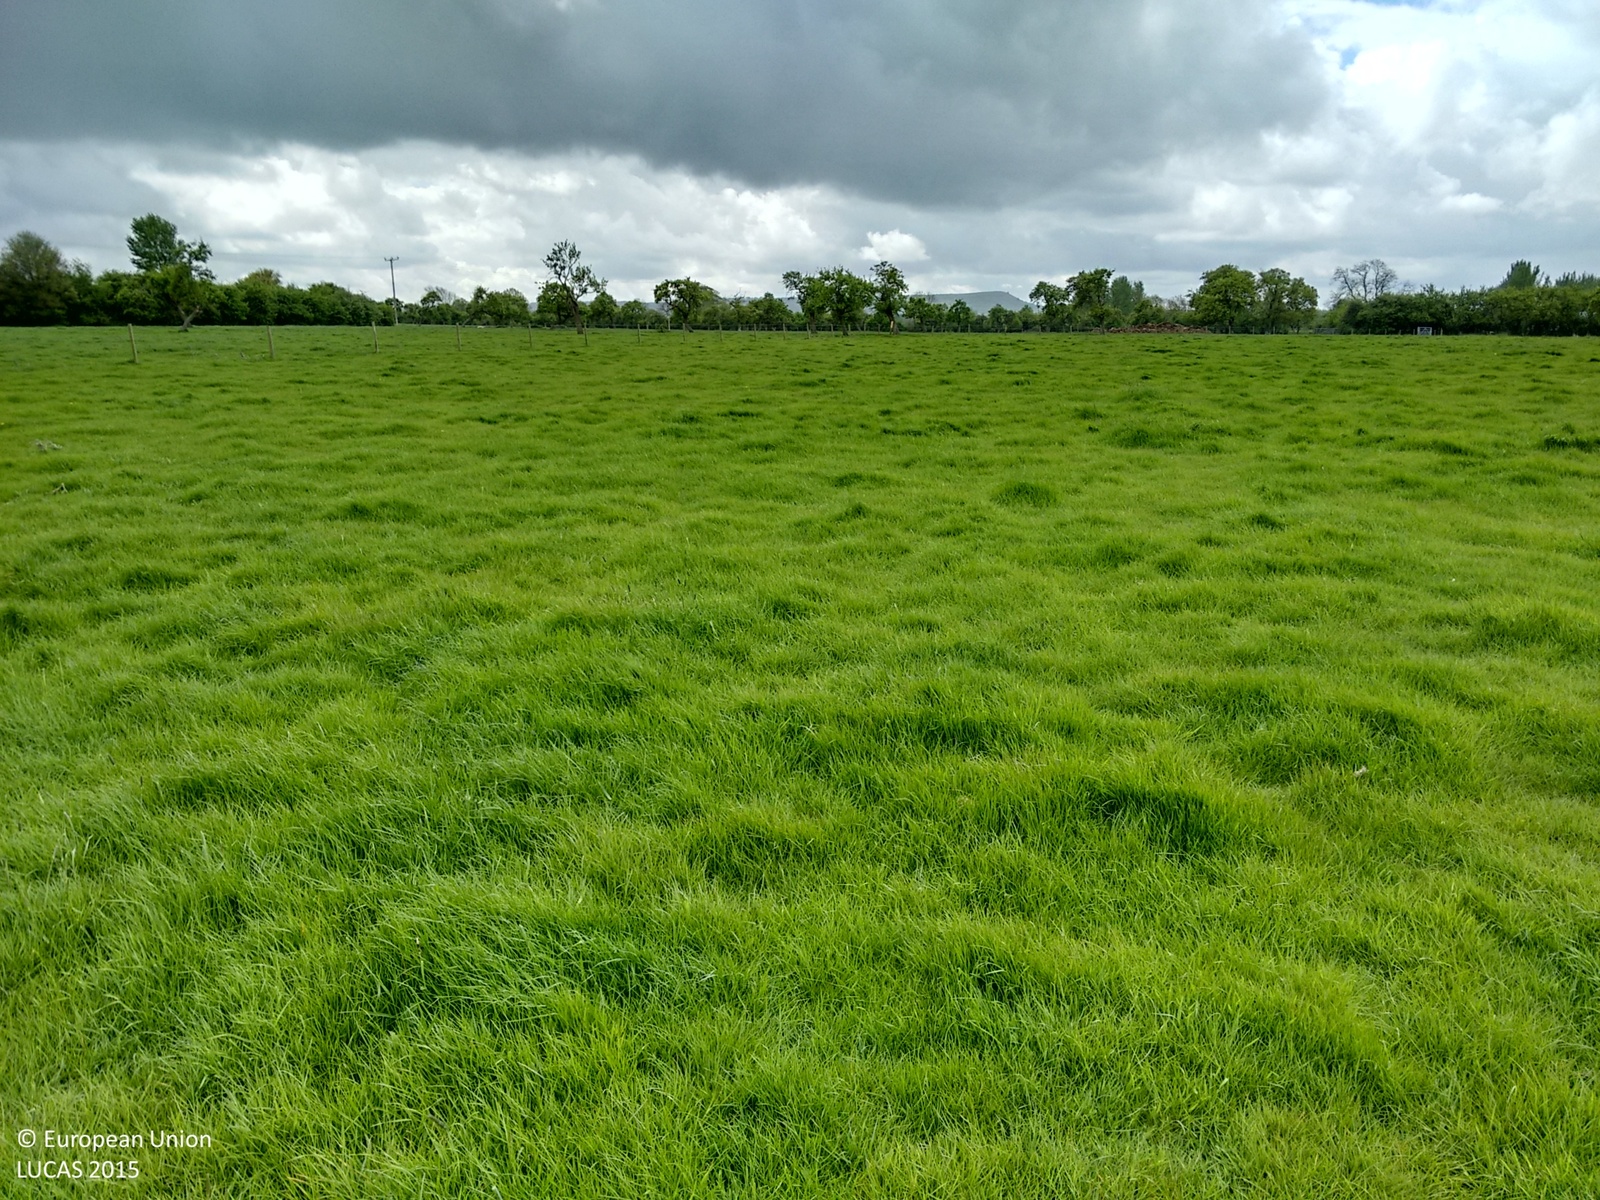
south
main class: Grassland
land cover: Grassland without tree/shrub cover
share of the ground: > 75 %
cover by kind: herbaceous plants 100 %
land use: Agriculture (excluding fallow land and kitchen gardens)
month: May
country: GB
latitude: 51.8832
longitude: -0.6013
